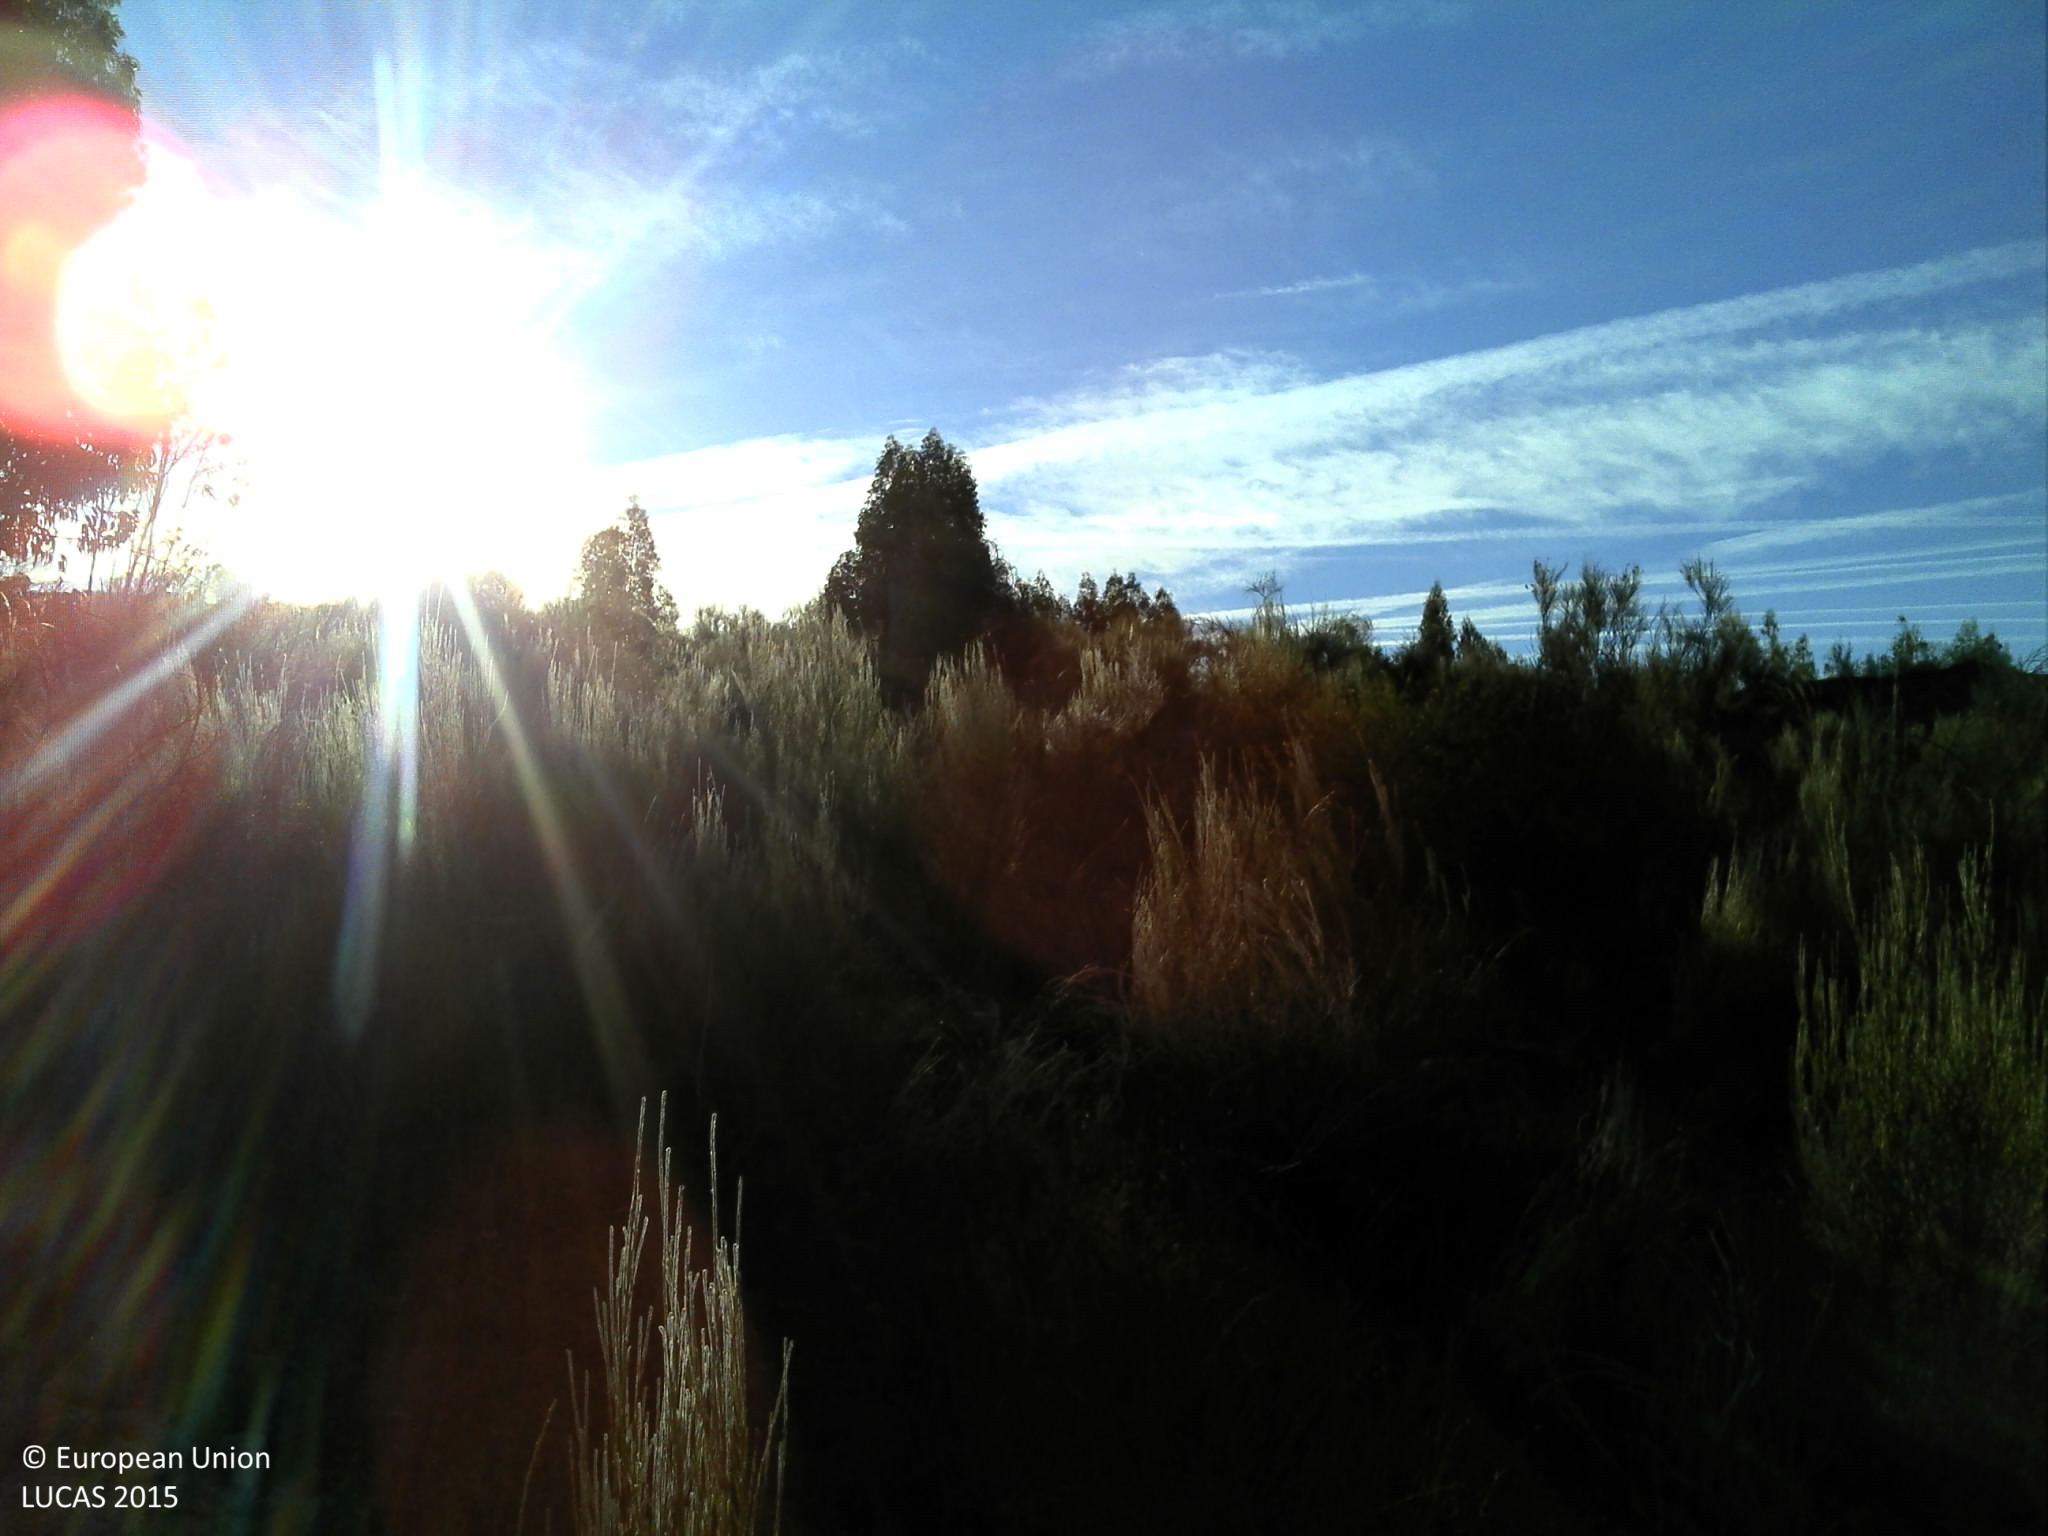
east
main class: Woodland
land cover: Broadleaved woodland
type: broadleaved evergreen forest
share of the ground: 10 - 25 %
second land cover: Shrubland without tree cover
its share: 25 - 50 %
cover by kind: shrubs 45 %, consolidated bare surface 20 %, broadleaved forest trees 15 %, herbaceous plants 15 %, unconsolidated bare surface 5 %
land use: Forestry
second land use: Agriculture (excluding fallow land and kitchen gardens)
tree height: > 5 m
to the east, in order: Broadleaved woodland; Shrubland without tree cover; Rocks and stones; Broadleaved woodland; Dry stone walls; Rocks and stones; Broadleaved woodland; Rocks and stones; Dry stone walls; Broadleaved woodland
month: August
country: PT
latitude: 39.4536
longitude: -7.5130
